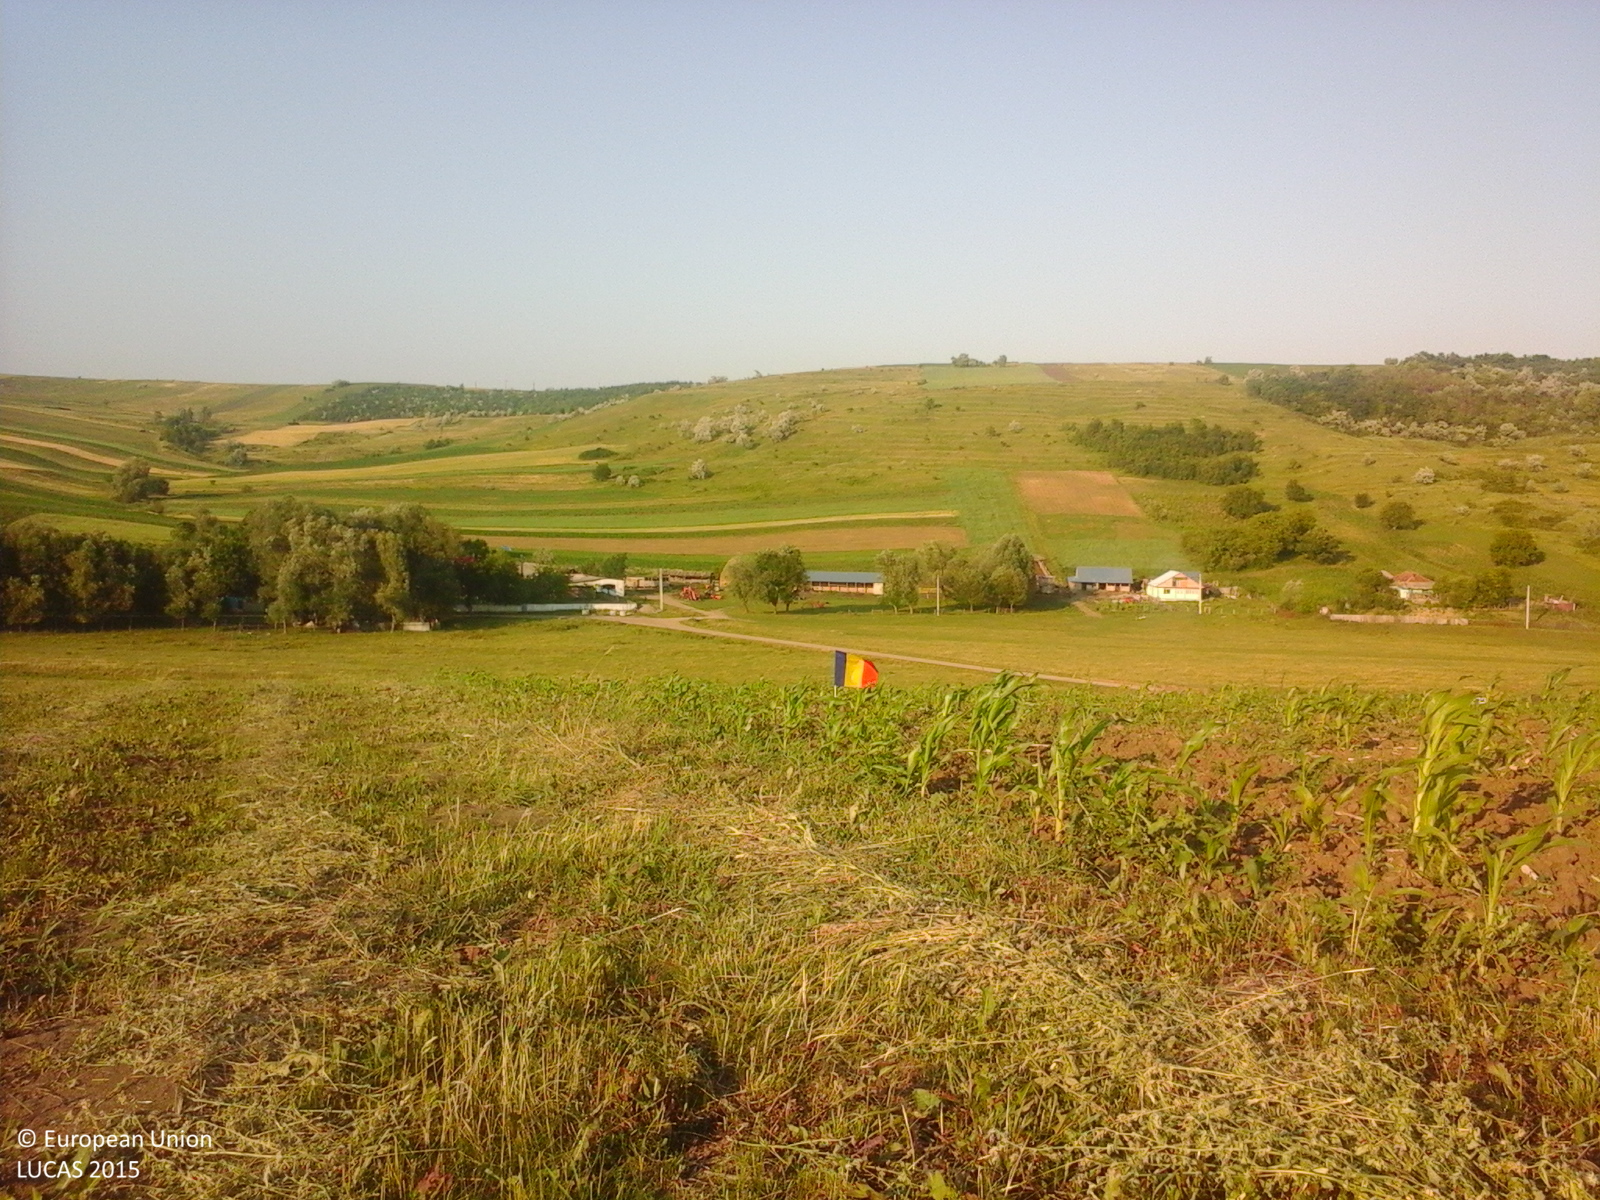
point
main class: Cropland
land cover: Maize
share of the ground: 10 - 25 %
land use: Agriculture (excluding fallow land and kitchen gardens)
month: June
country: RO
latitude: 46.6990
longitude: 27.3848
